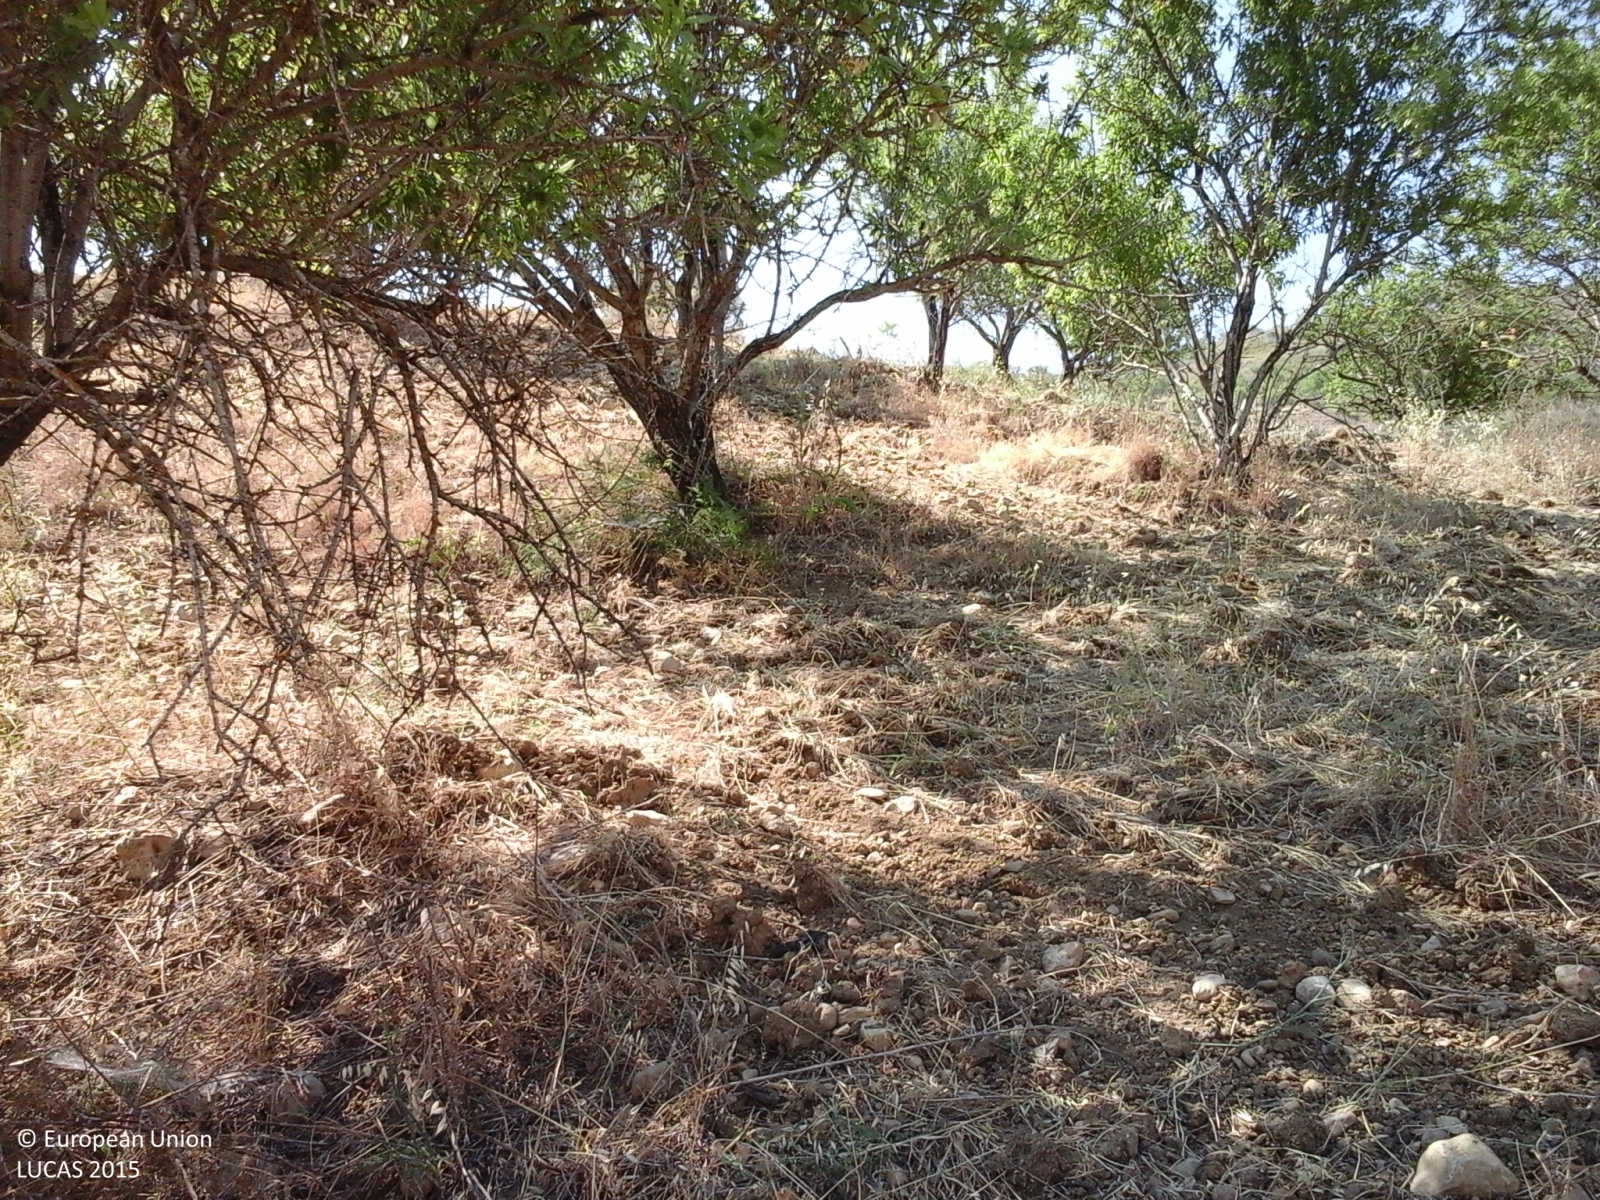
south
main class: Cropland
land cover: Nuts trees
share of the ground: 25 - 50 %
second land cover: Spontaneously vegetated surfaces
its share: > 75 %
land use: Agriculture (excluding fallow land and kitchen gardens)
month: July
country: IT
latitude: 37.4473
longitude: 13.4886
